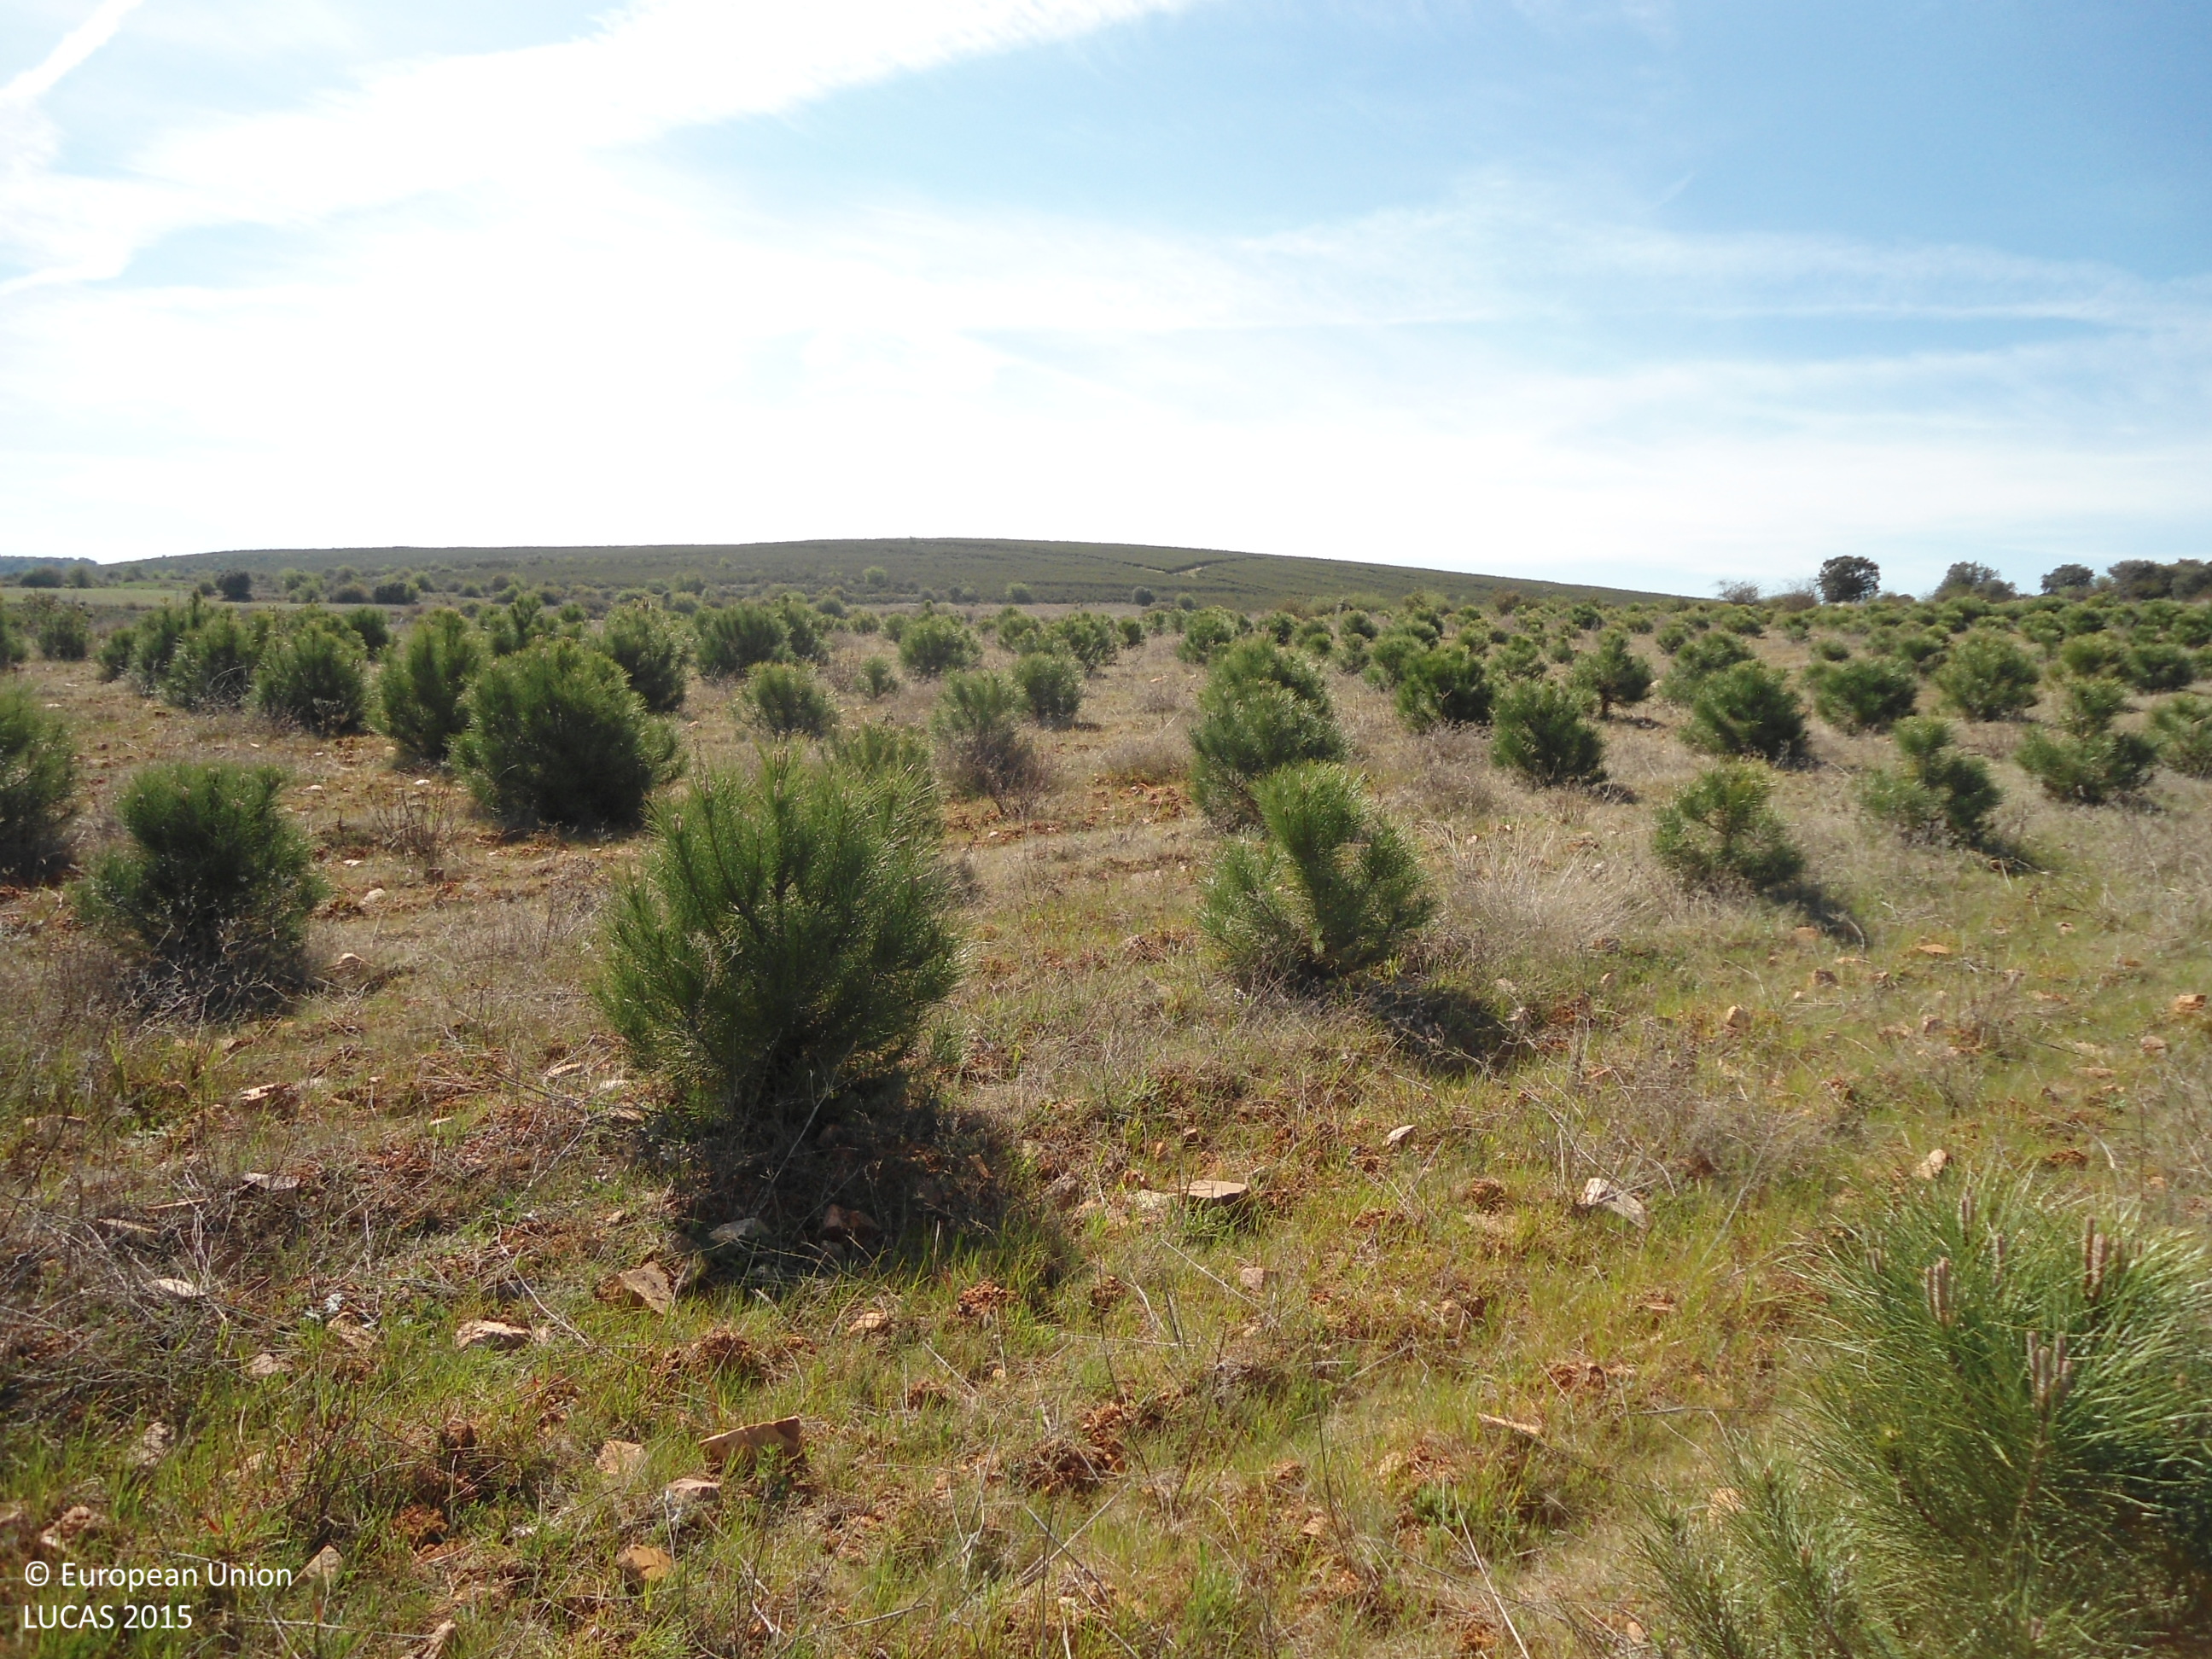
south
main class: Woodland
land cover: Pine dominated coniferous woodland
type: coniferous forest of the mediterranean region
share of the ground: 25 - 50 %
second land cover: Spontaneously vegetated surfaces
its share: 25 - 50 %
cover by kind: herbaceous plants 55 %, coniferous forest trees 45 %
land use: Forestry
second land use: Fallow land
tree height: < 5 m
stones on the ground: < 10 %
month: April
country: ES
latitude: 41.7057
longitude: -5.8709
